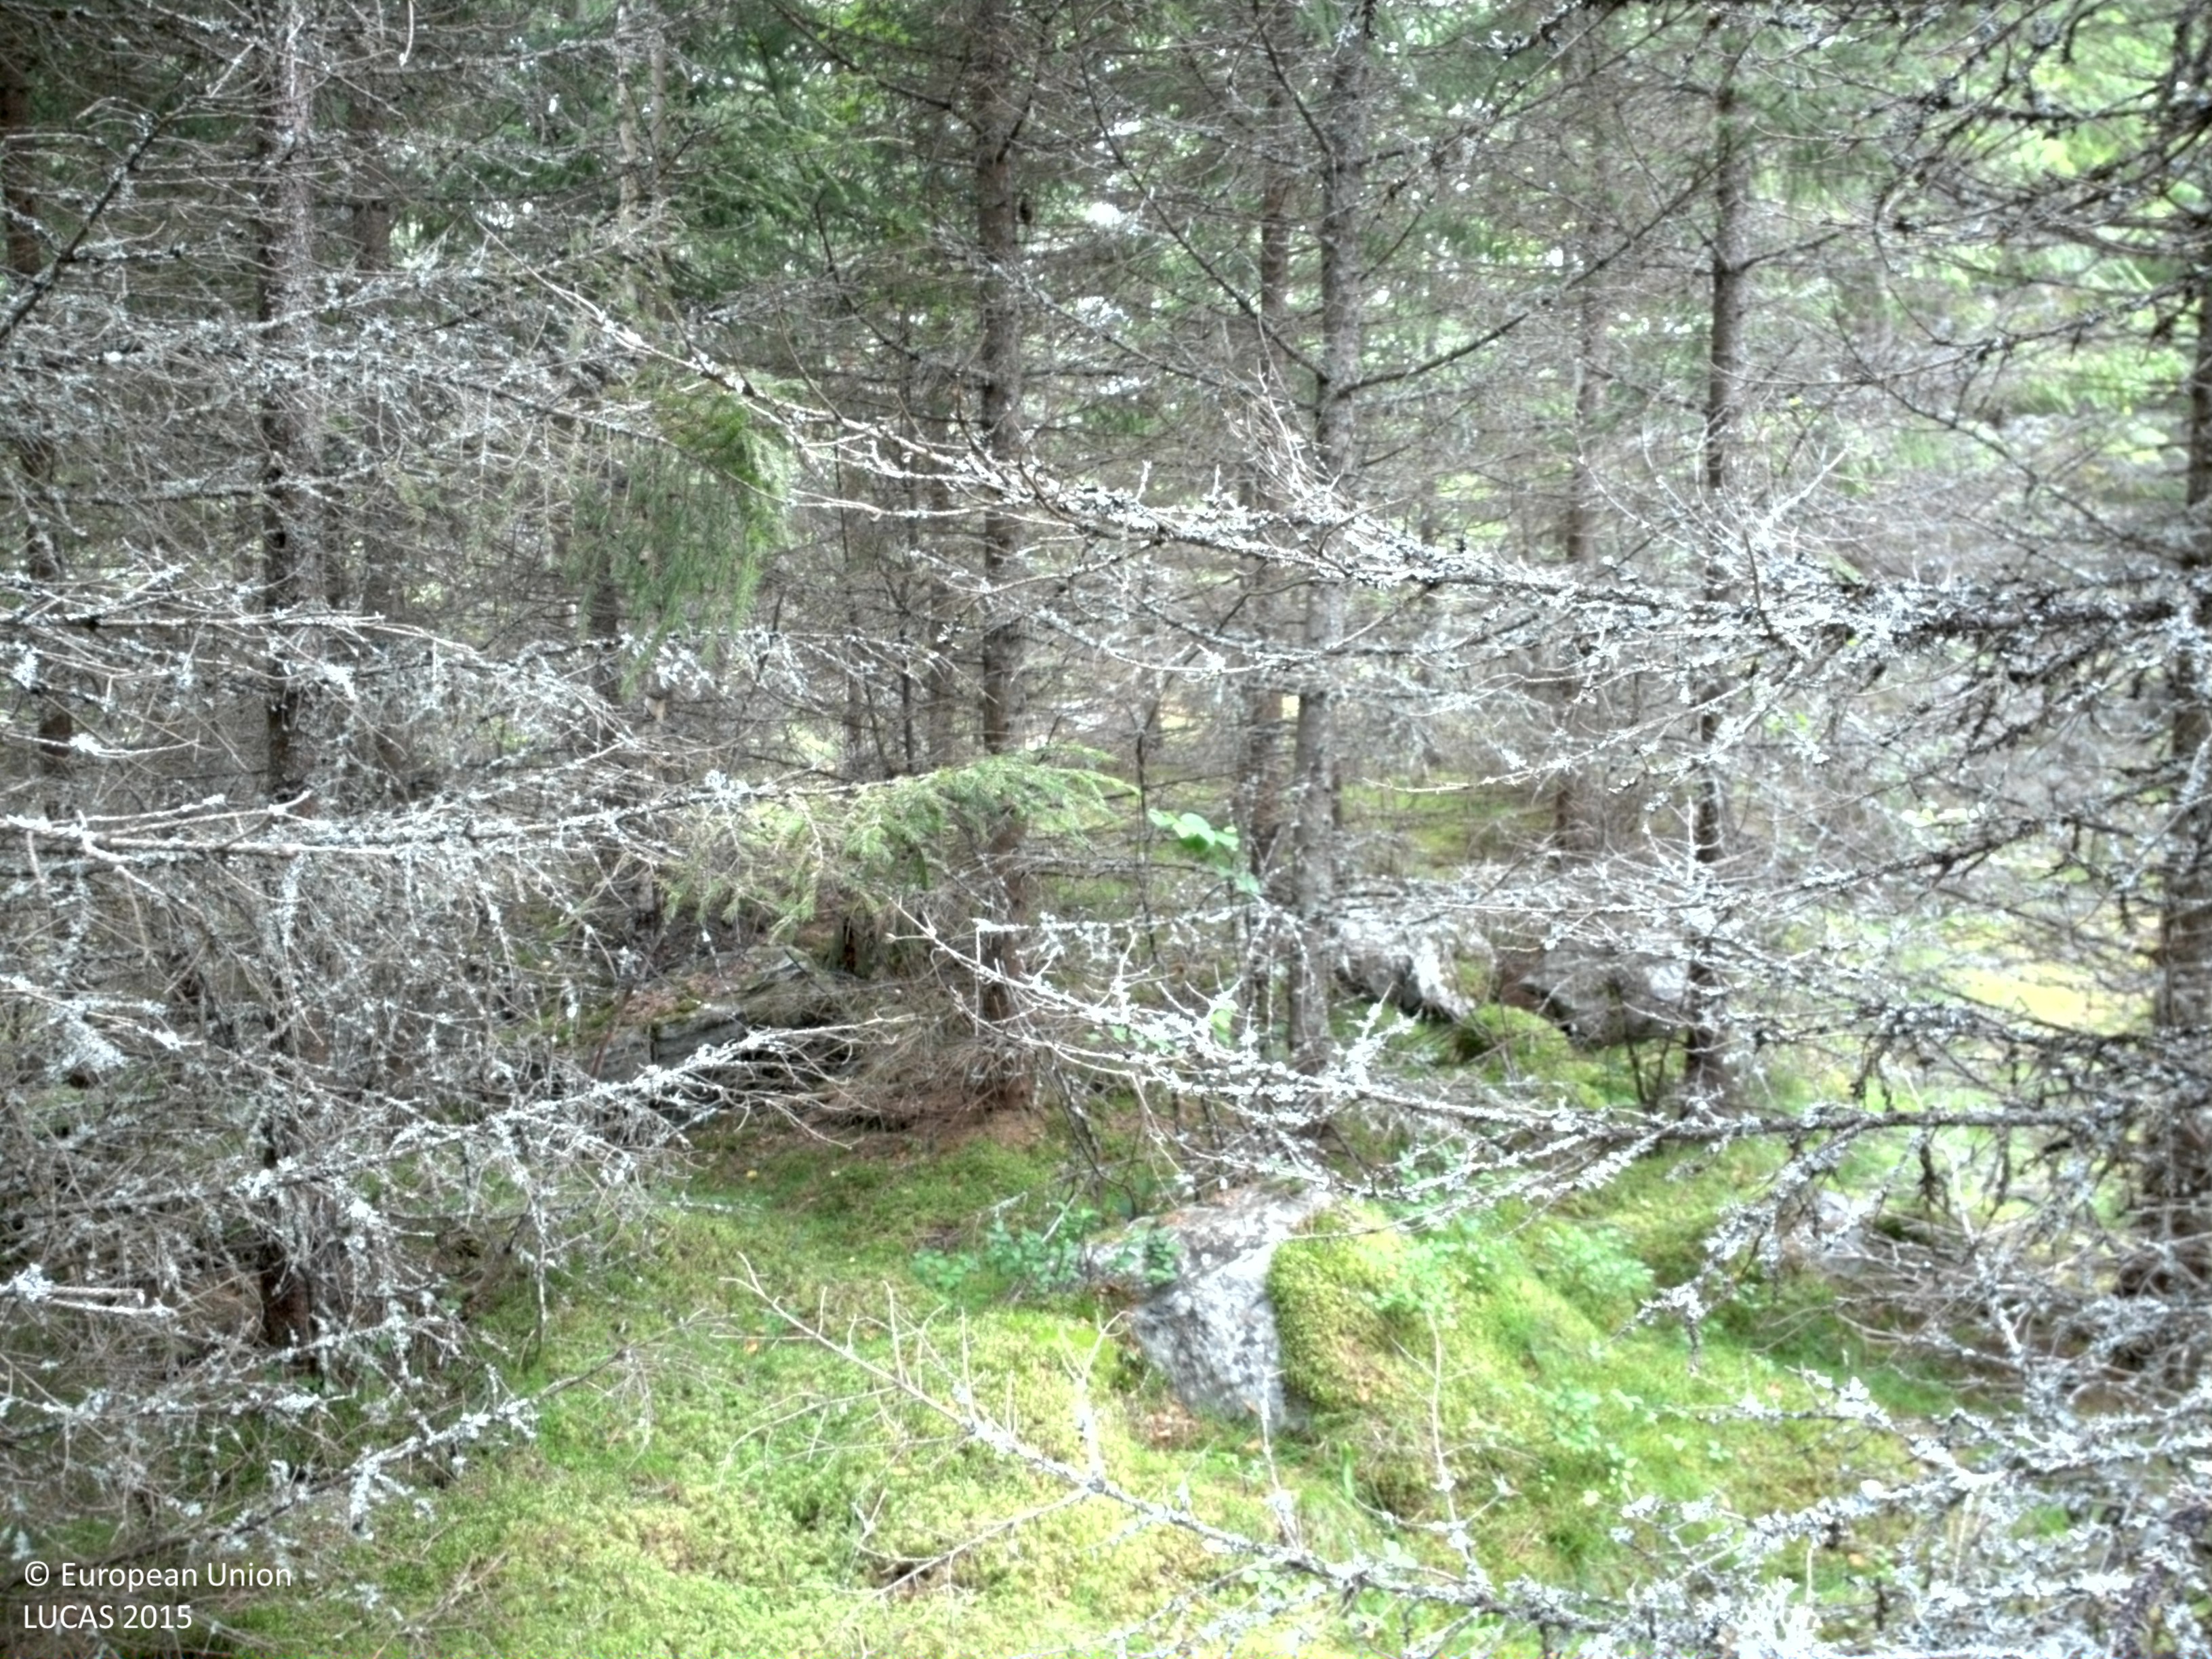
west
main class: Woodland
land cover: Spruce dominated coniferous woodland
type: boreal forest
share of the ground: 25 - 50 %
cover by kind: coniferous forest trees 45 %, lichens and mosses 45 %, herbaceous plants 10 %
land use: Forestry
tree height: < 5 m
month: July
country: SE
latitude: 58.7628
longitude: 15.3354
